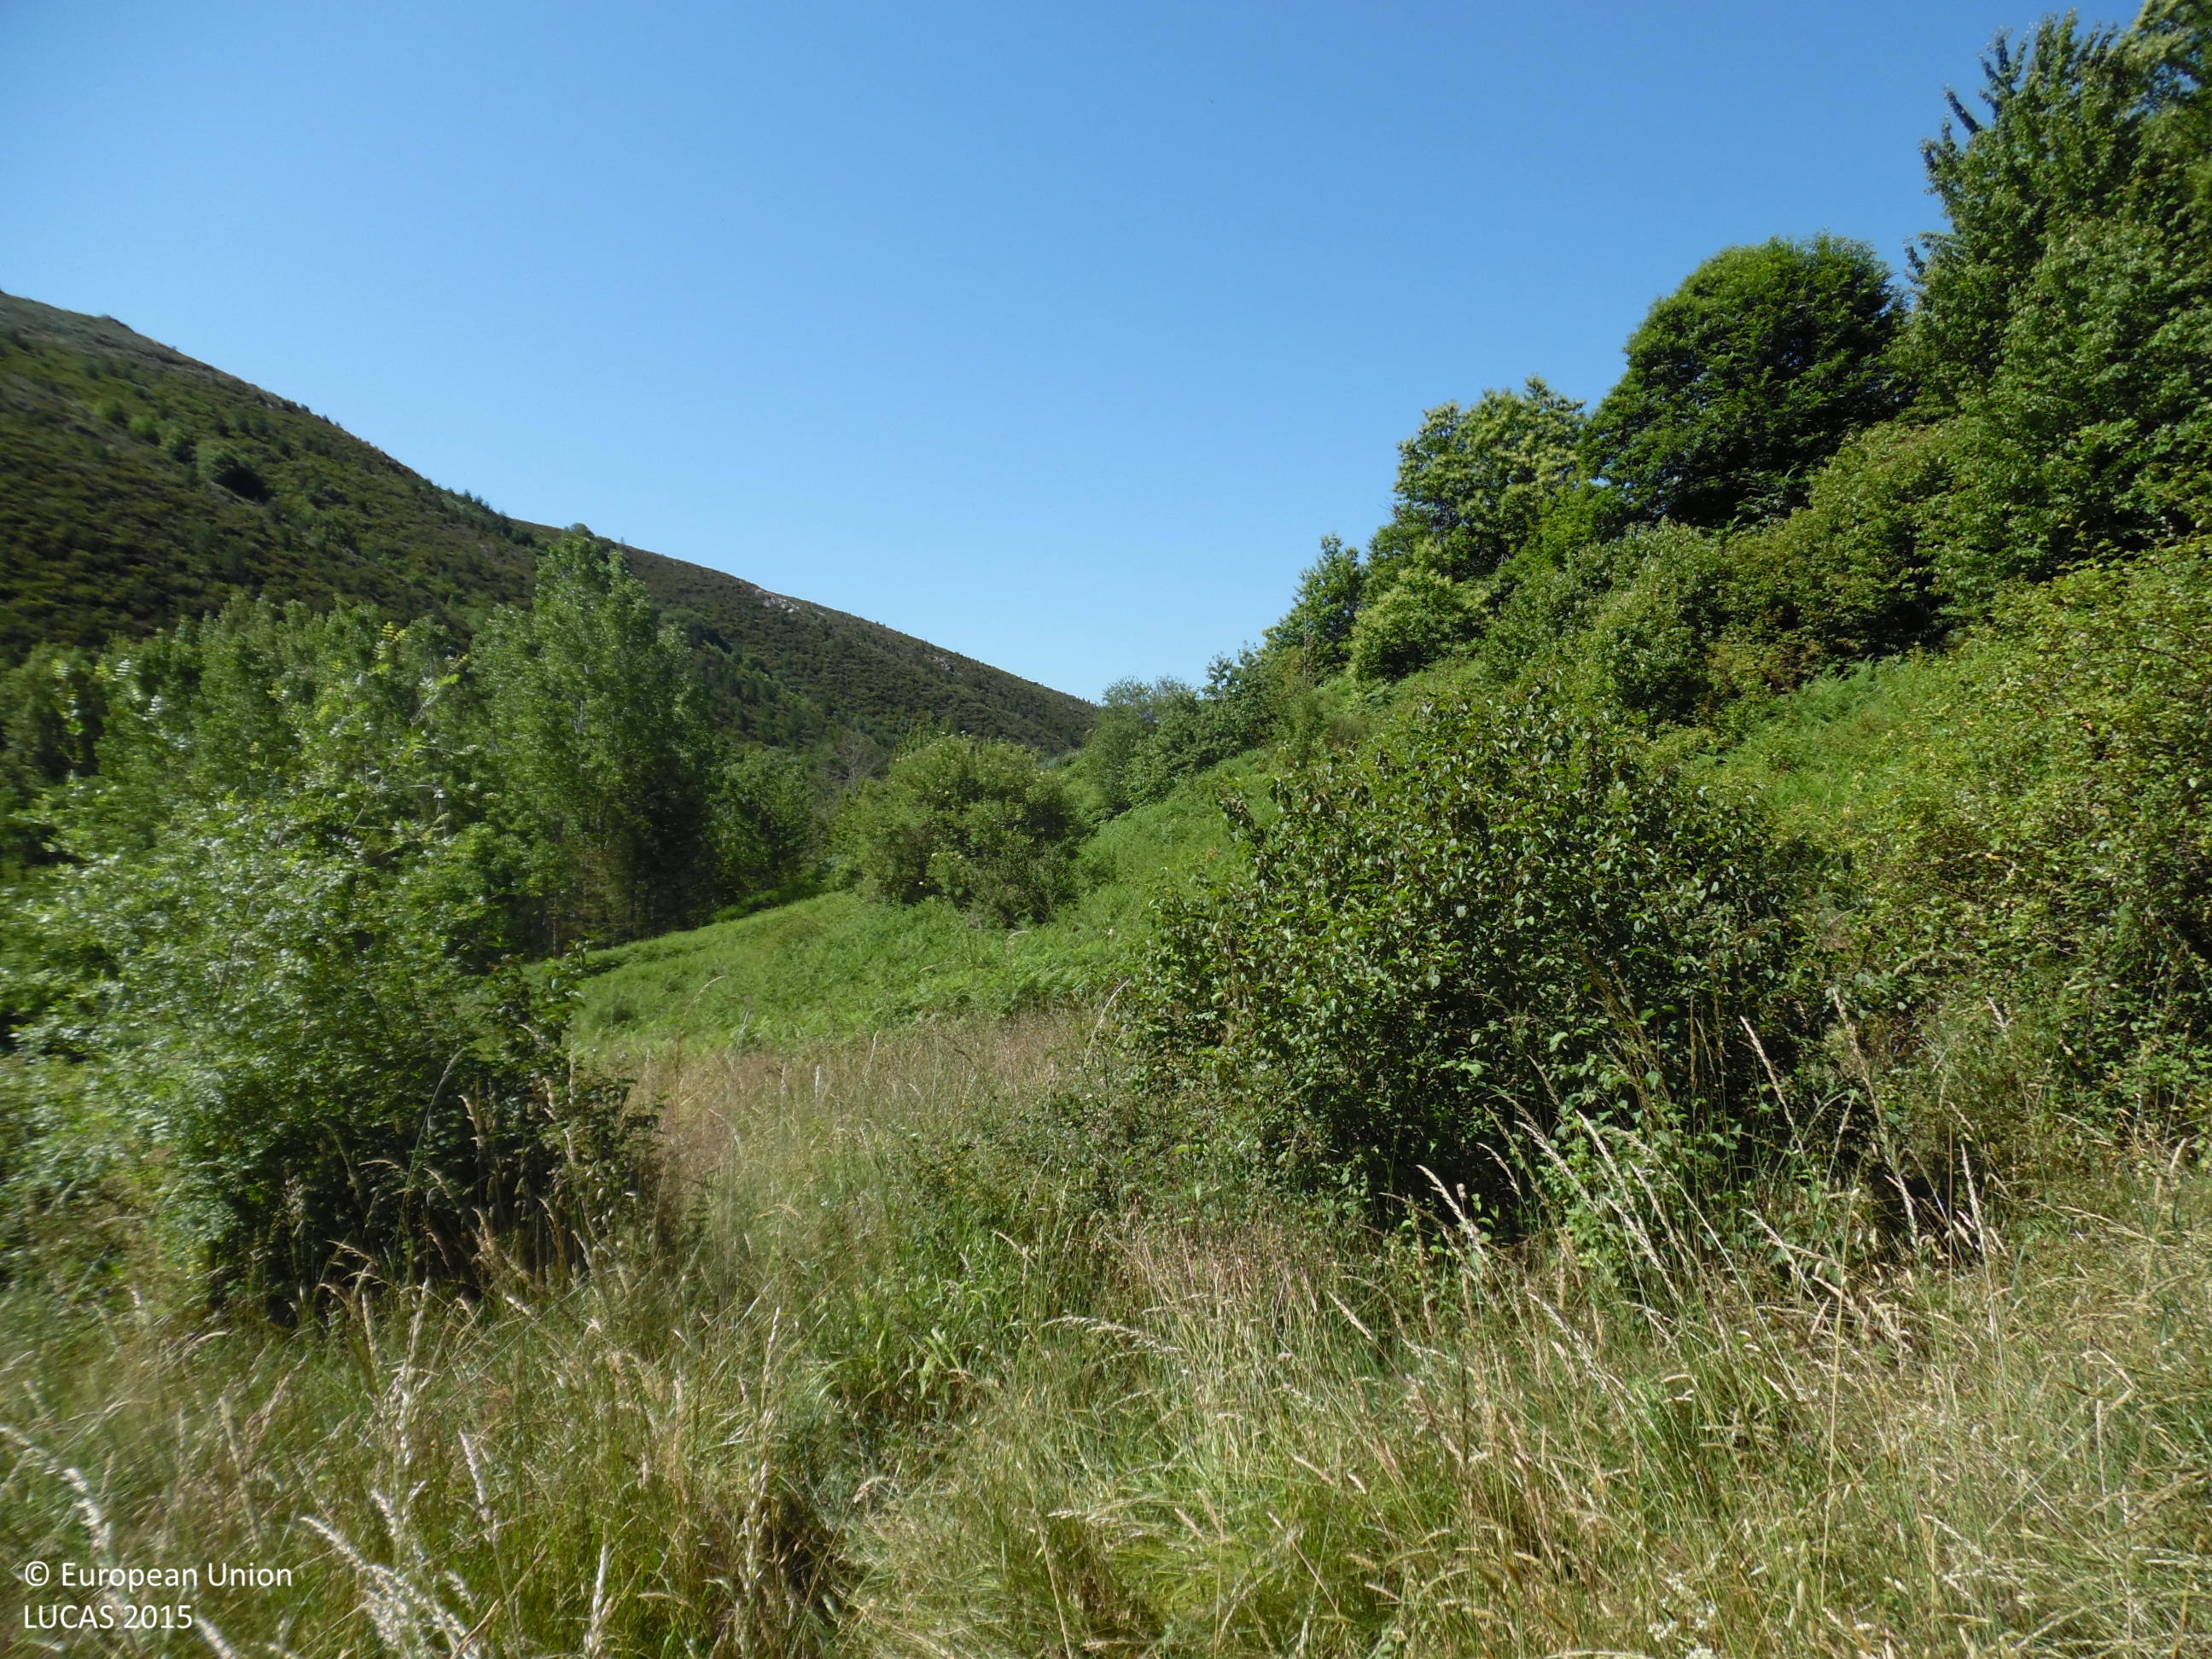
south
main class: Grassland
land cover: Grassland without tree/shrub cover
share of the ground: 50 - 75 %
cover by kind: herbaceous plants 95 %, shrubs 5 %
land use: Agriculture (excluding fallow land and kitchen gardens)
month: June
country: ES
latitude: 42.5695
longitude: -6.8771
